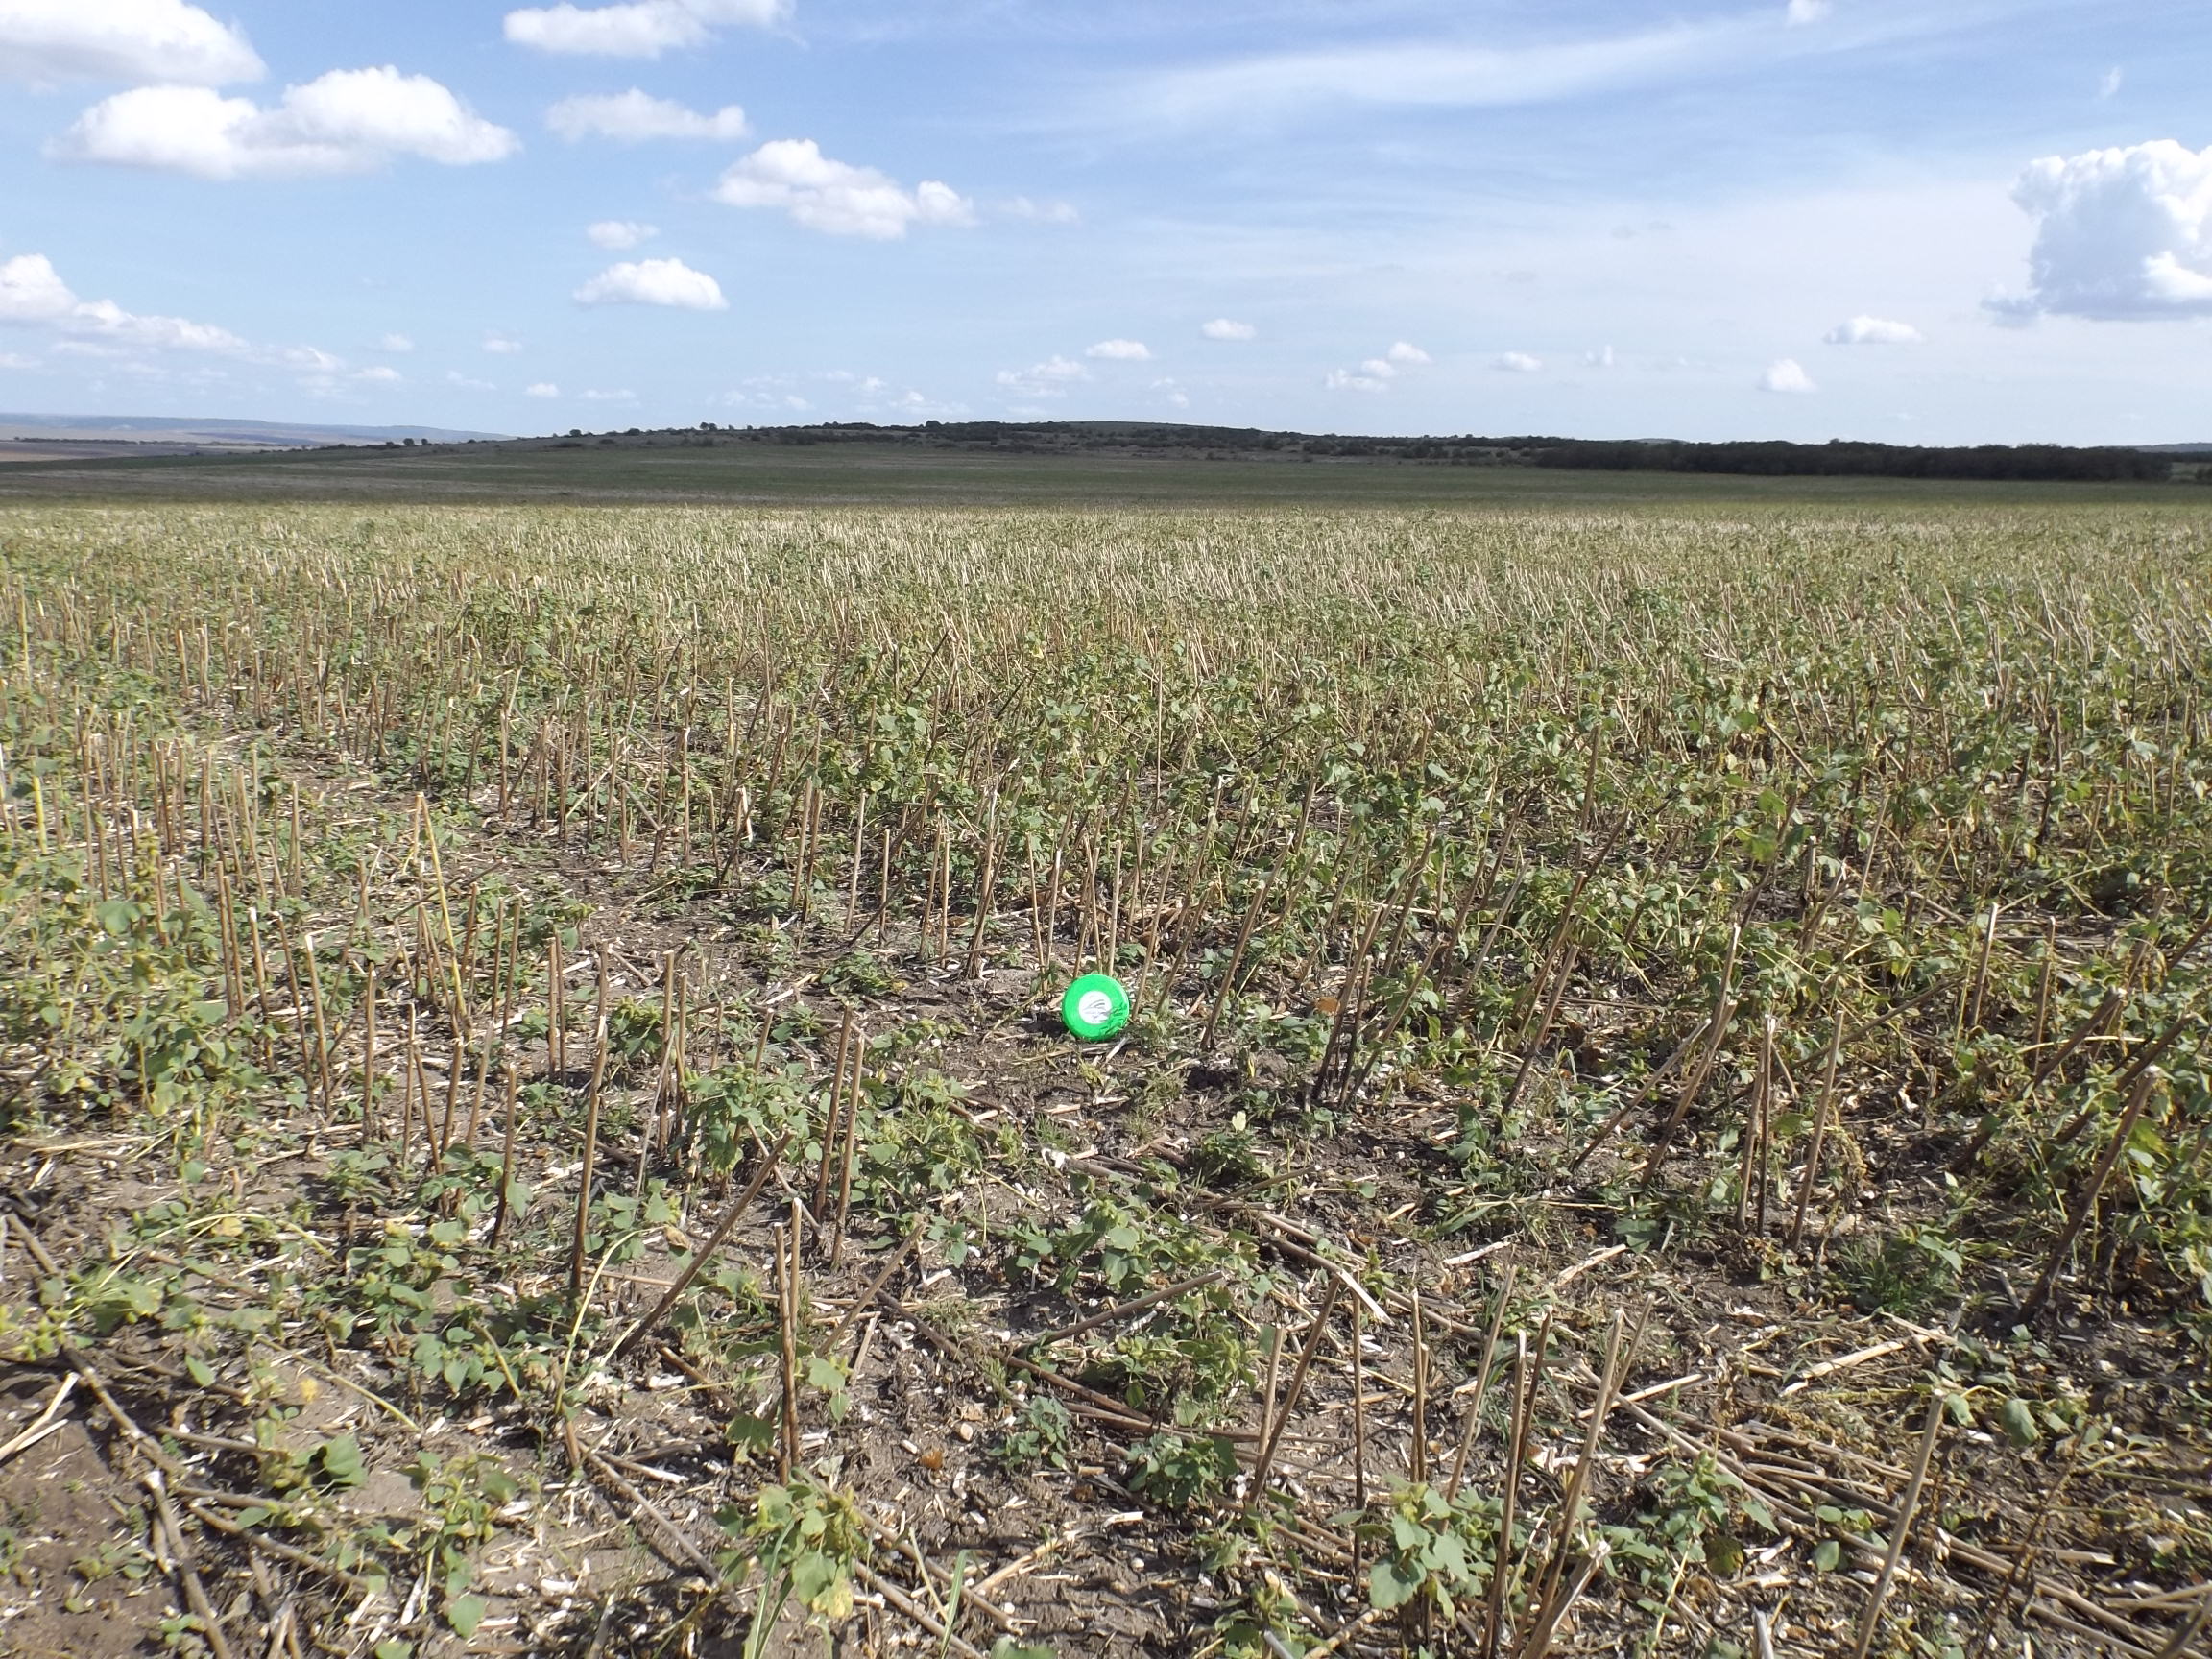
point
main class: Cropland
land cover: Sunflower
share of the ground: < 10 %
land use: Agriculture (excluding fallow land and kitchen gardens)
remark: Harvested field
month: September
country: BG
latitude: 43.2832
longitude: 27.4411
